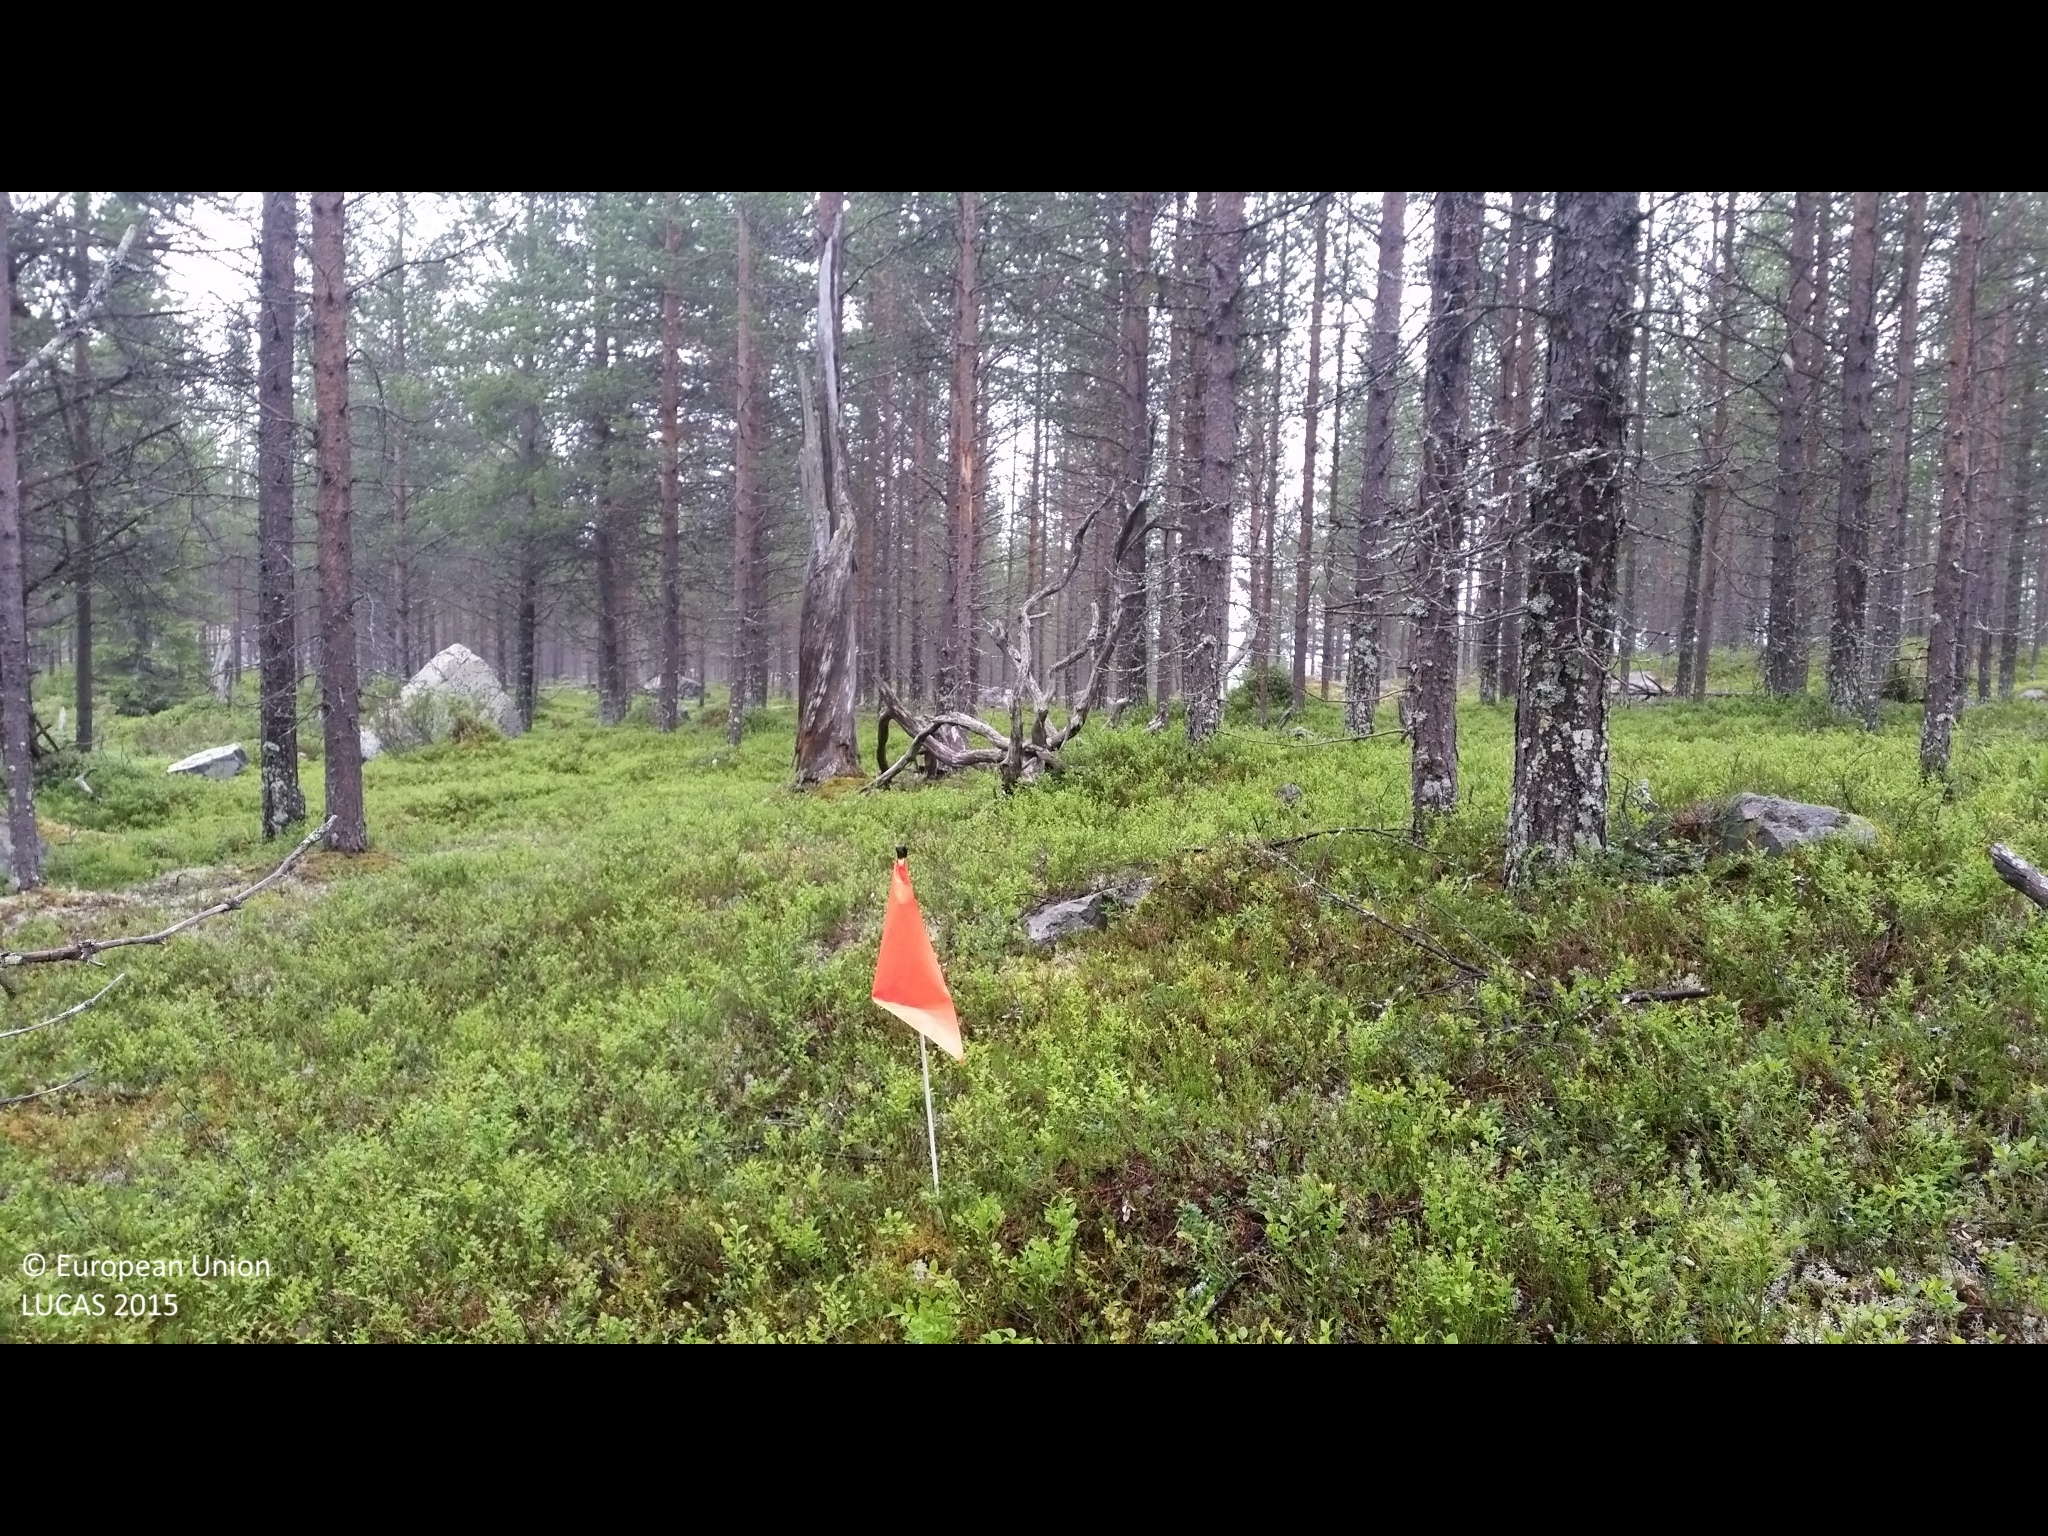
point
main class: Woodland
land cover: Pine dominated coniferous woodland
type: boreal forest
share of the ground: 50 - 75 %
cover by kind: coniferous forest trees 65 %, shrubs 25 %, lichens and mosses 5 %, consolidated bare surface 5 %
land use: Forestry
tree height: > 5 m
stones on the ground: > 50 %
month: July
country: SE
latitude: 65.8823
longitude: 18.0934
